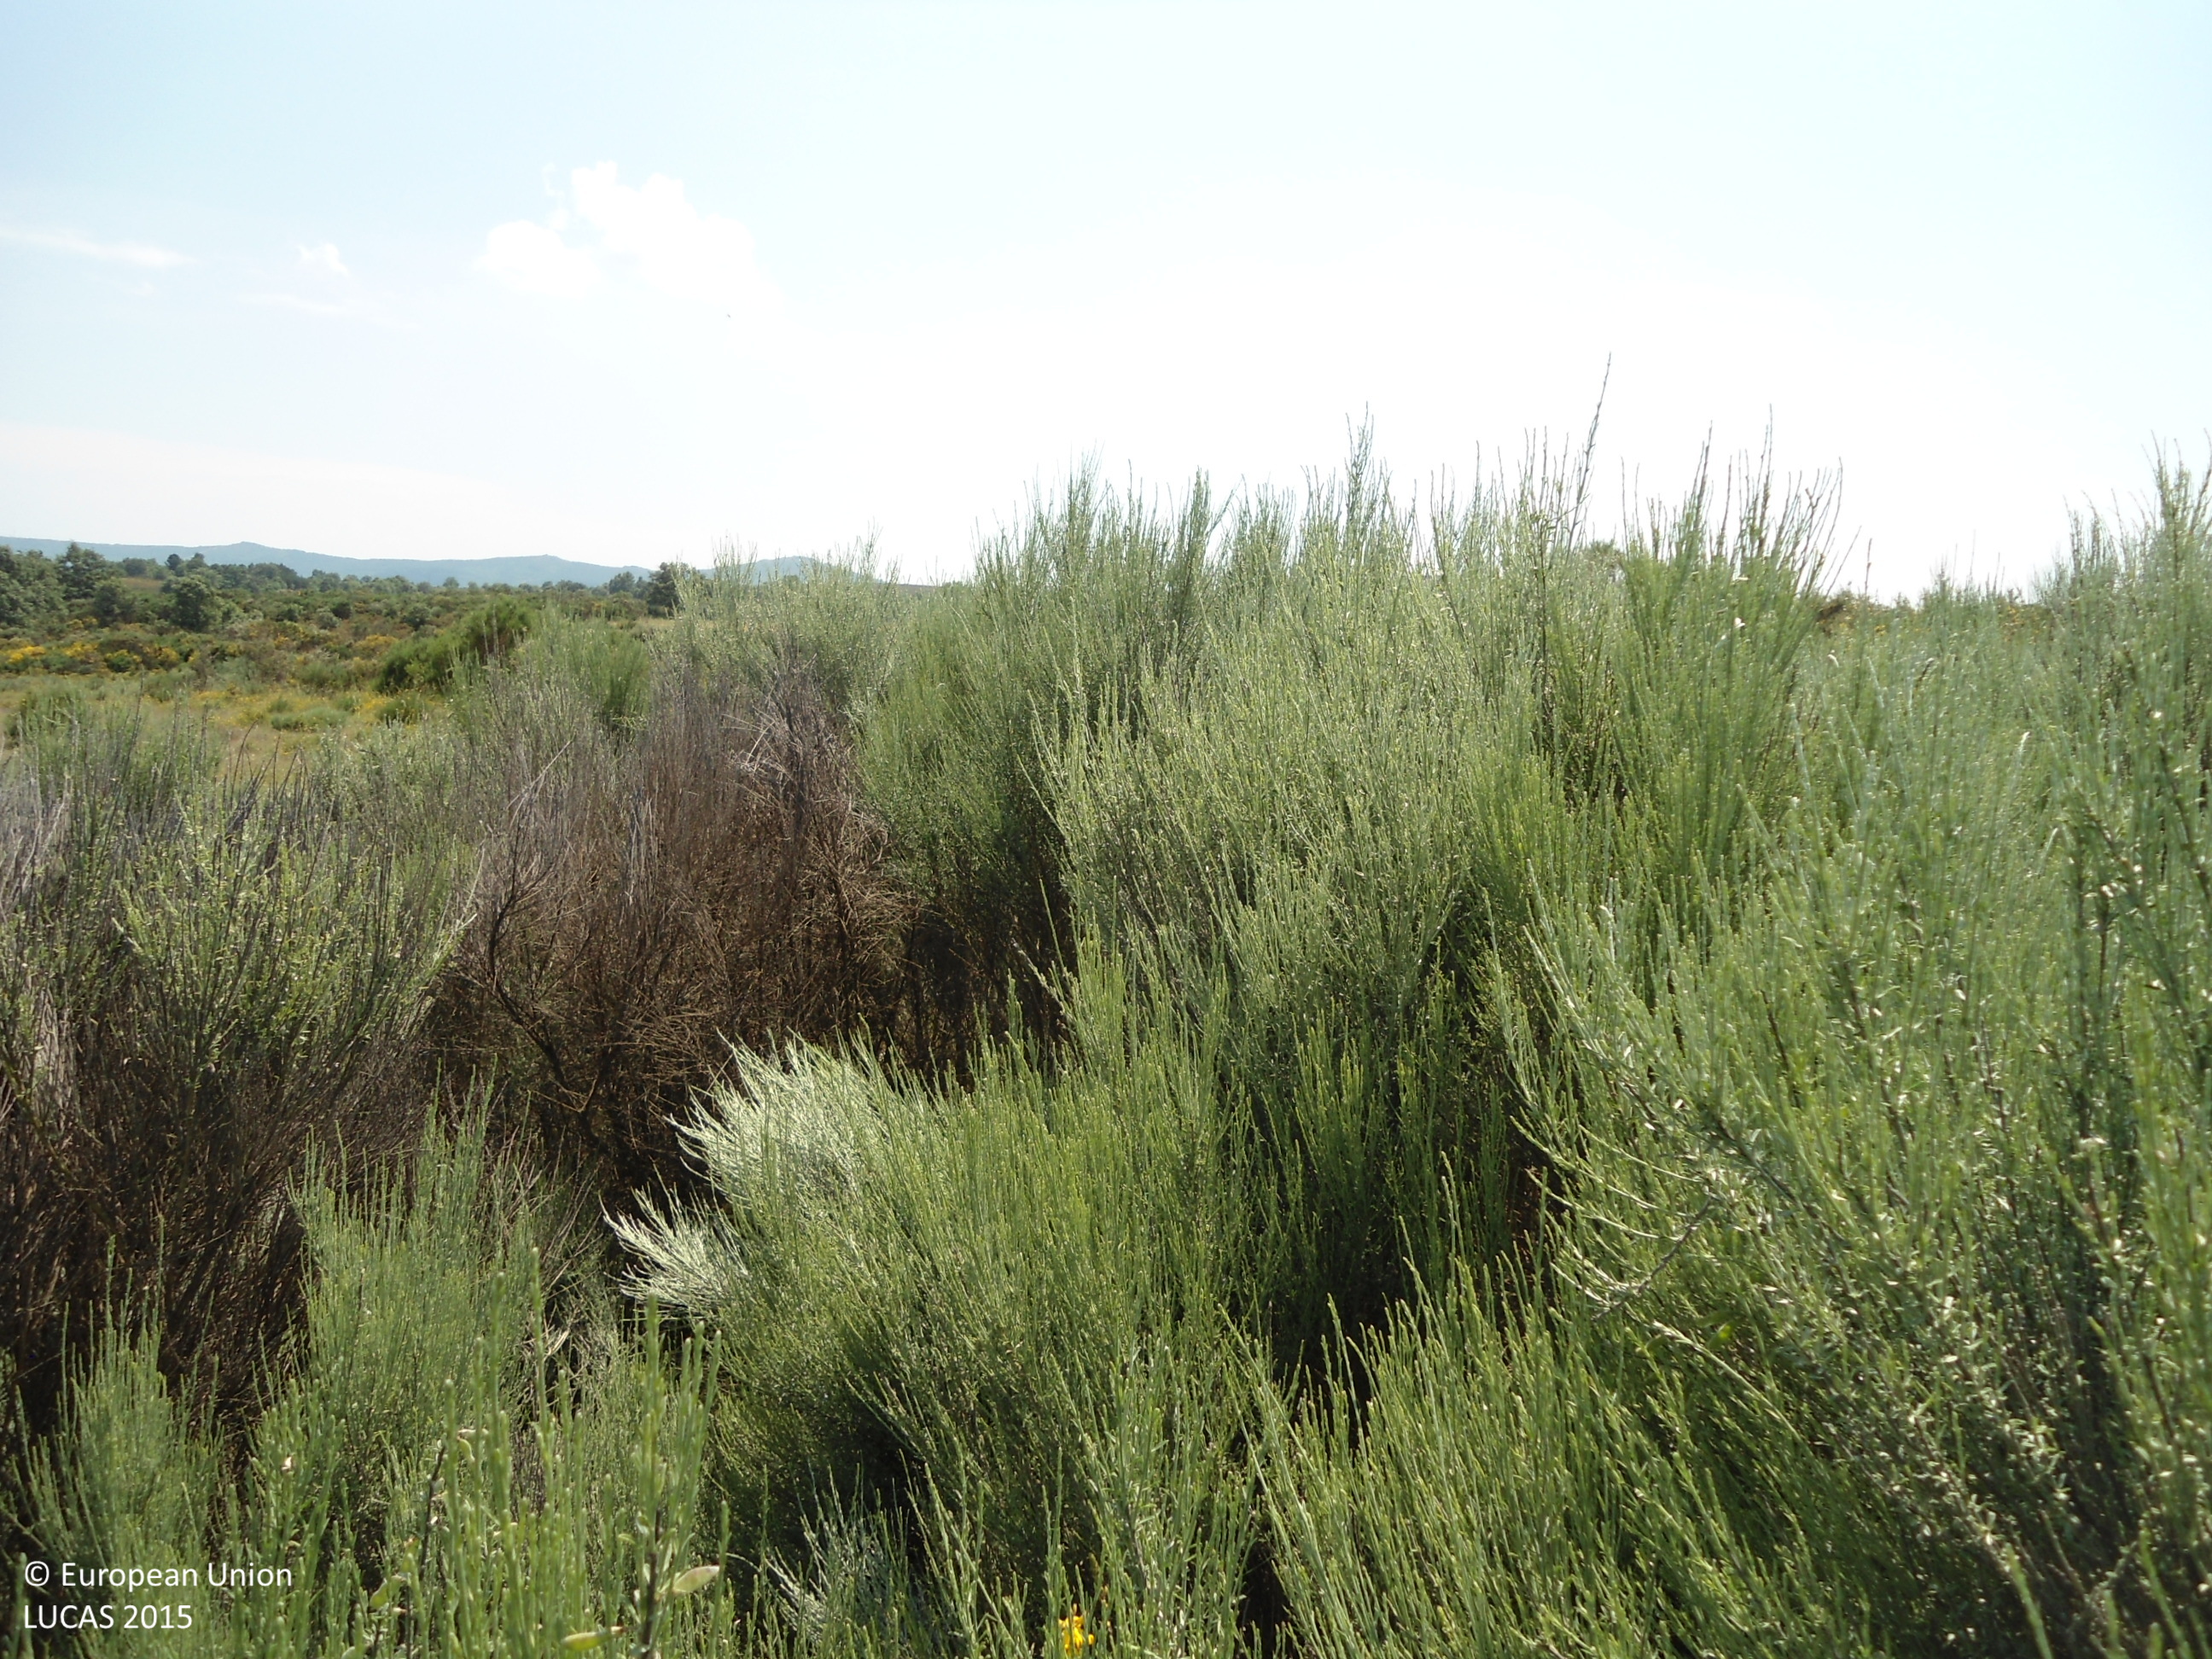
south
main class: Shrubland
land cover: Shrubland without tree cover
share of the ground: > 75 %
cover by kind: shrubs 95 %, herbaceous plants 5 %
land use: Semi-natural and natural areas not in use
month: June
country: ES
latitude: 41.9749
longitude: -6.3620
